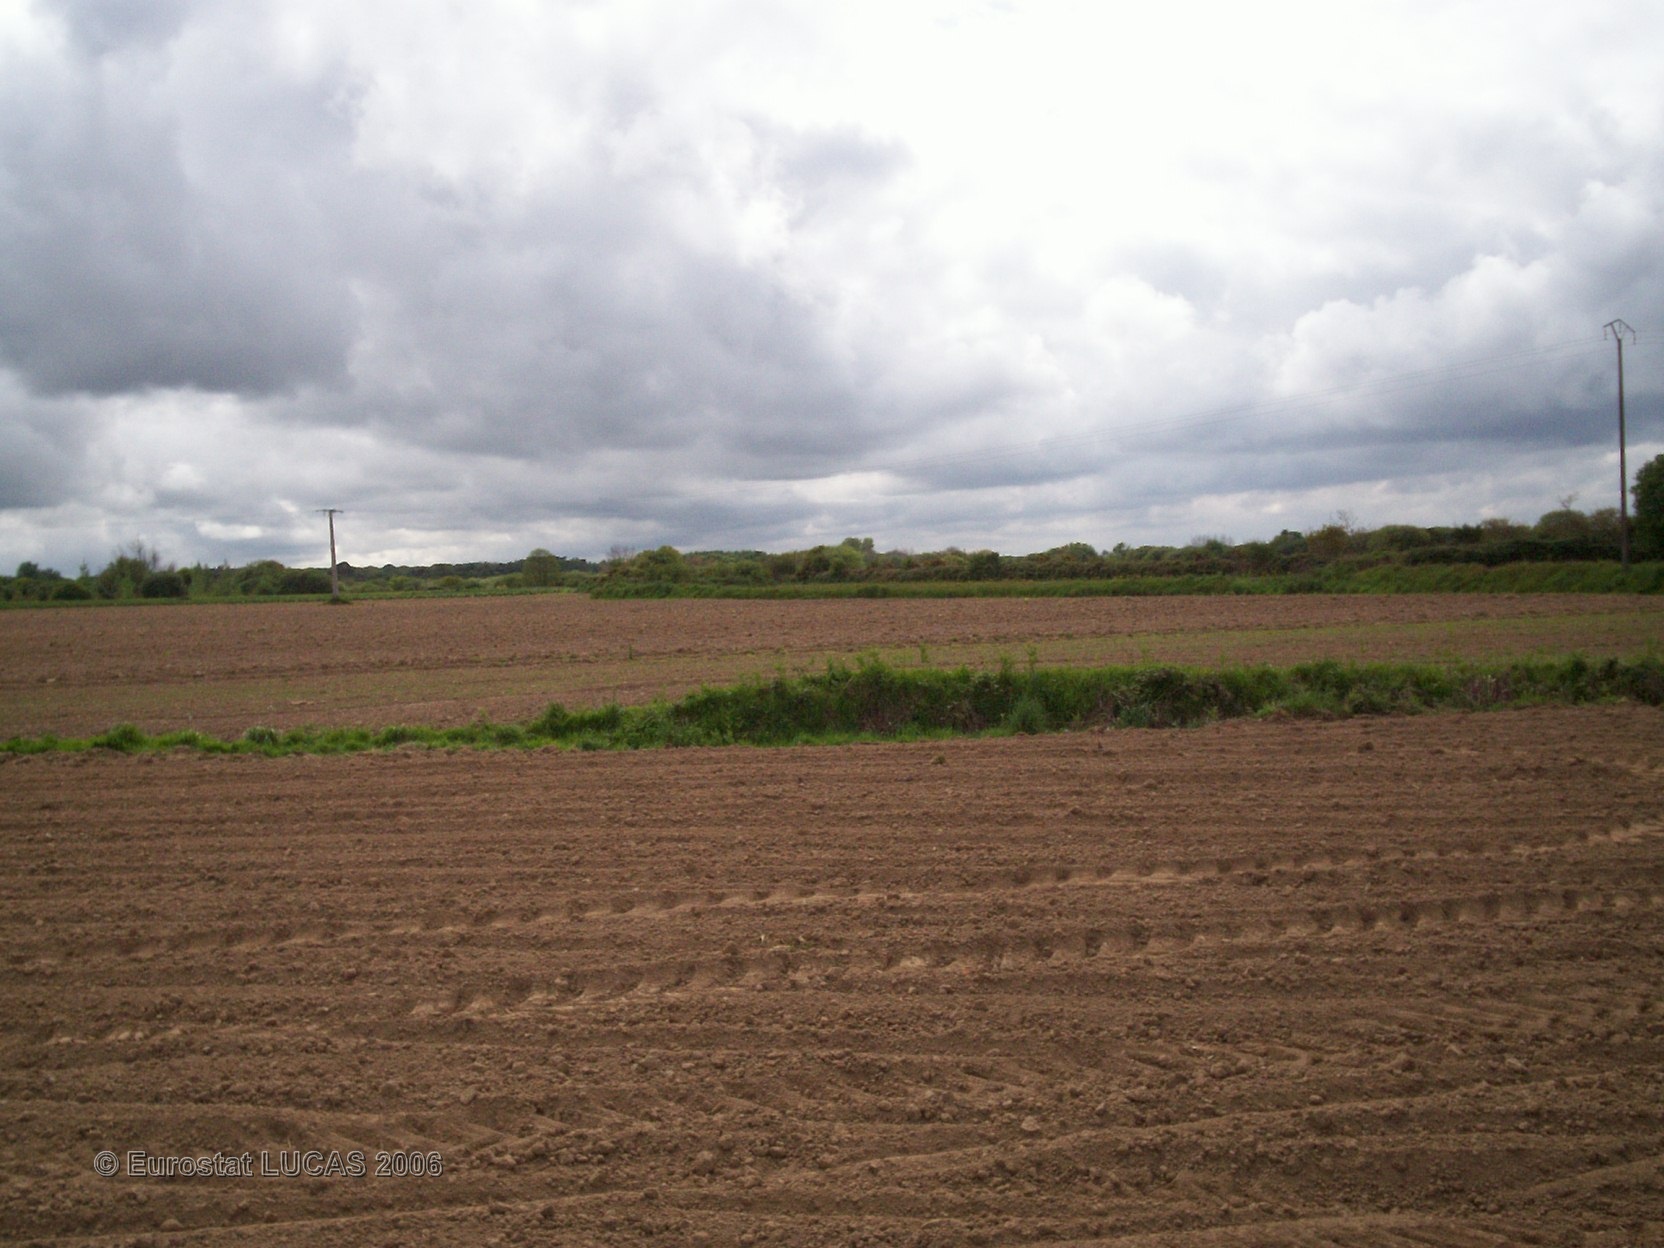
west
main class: Cropland
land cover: Maize
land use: Agriculture (excluding fallow land and kitchen gardens)
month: May
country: FR
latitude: 48.6731
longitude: -3.7320
